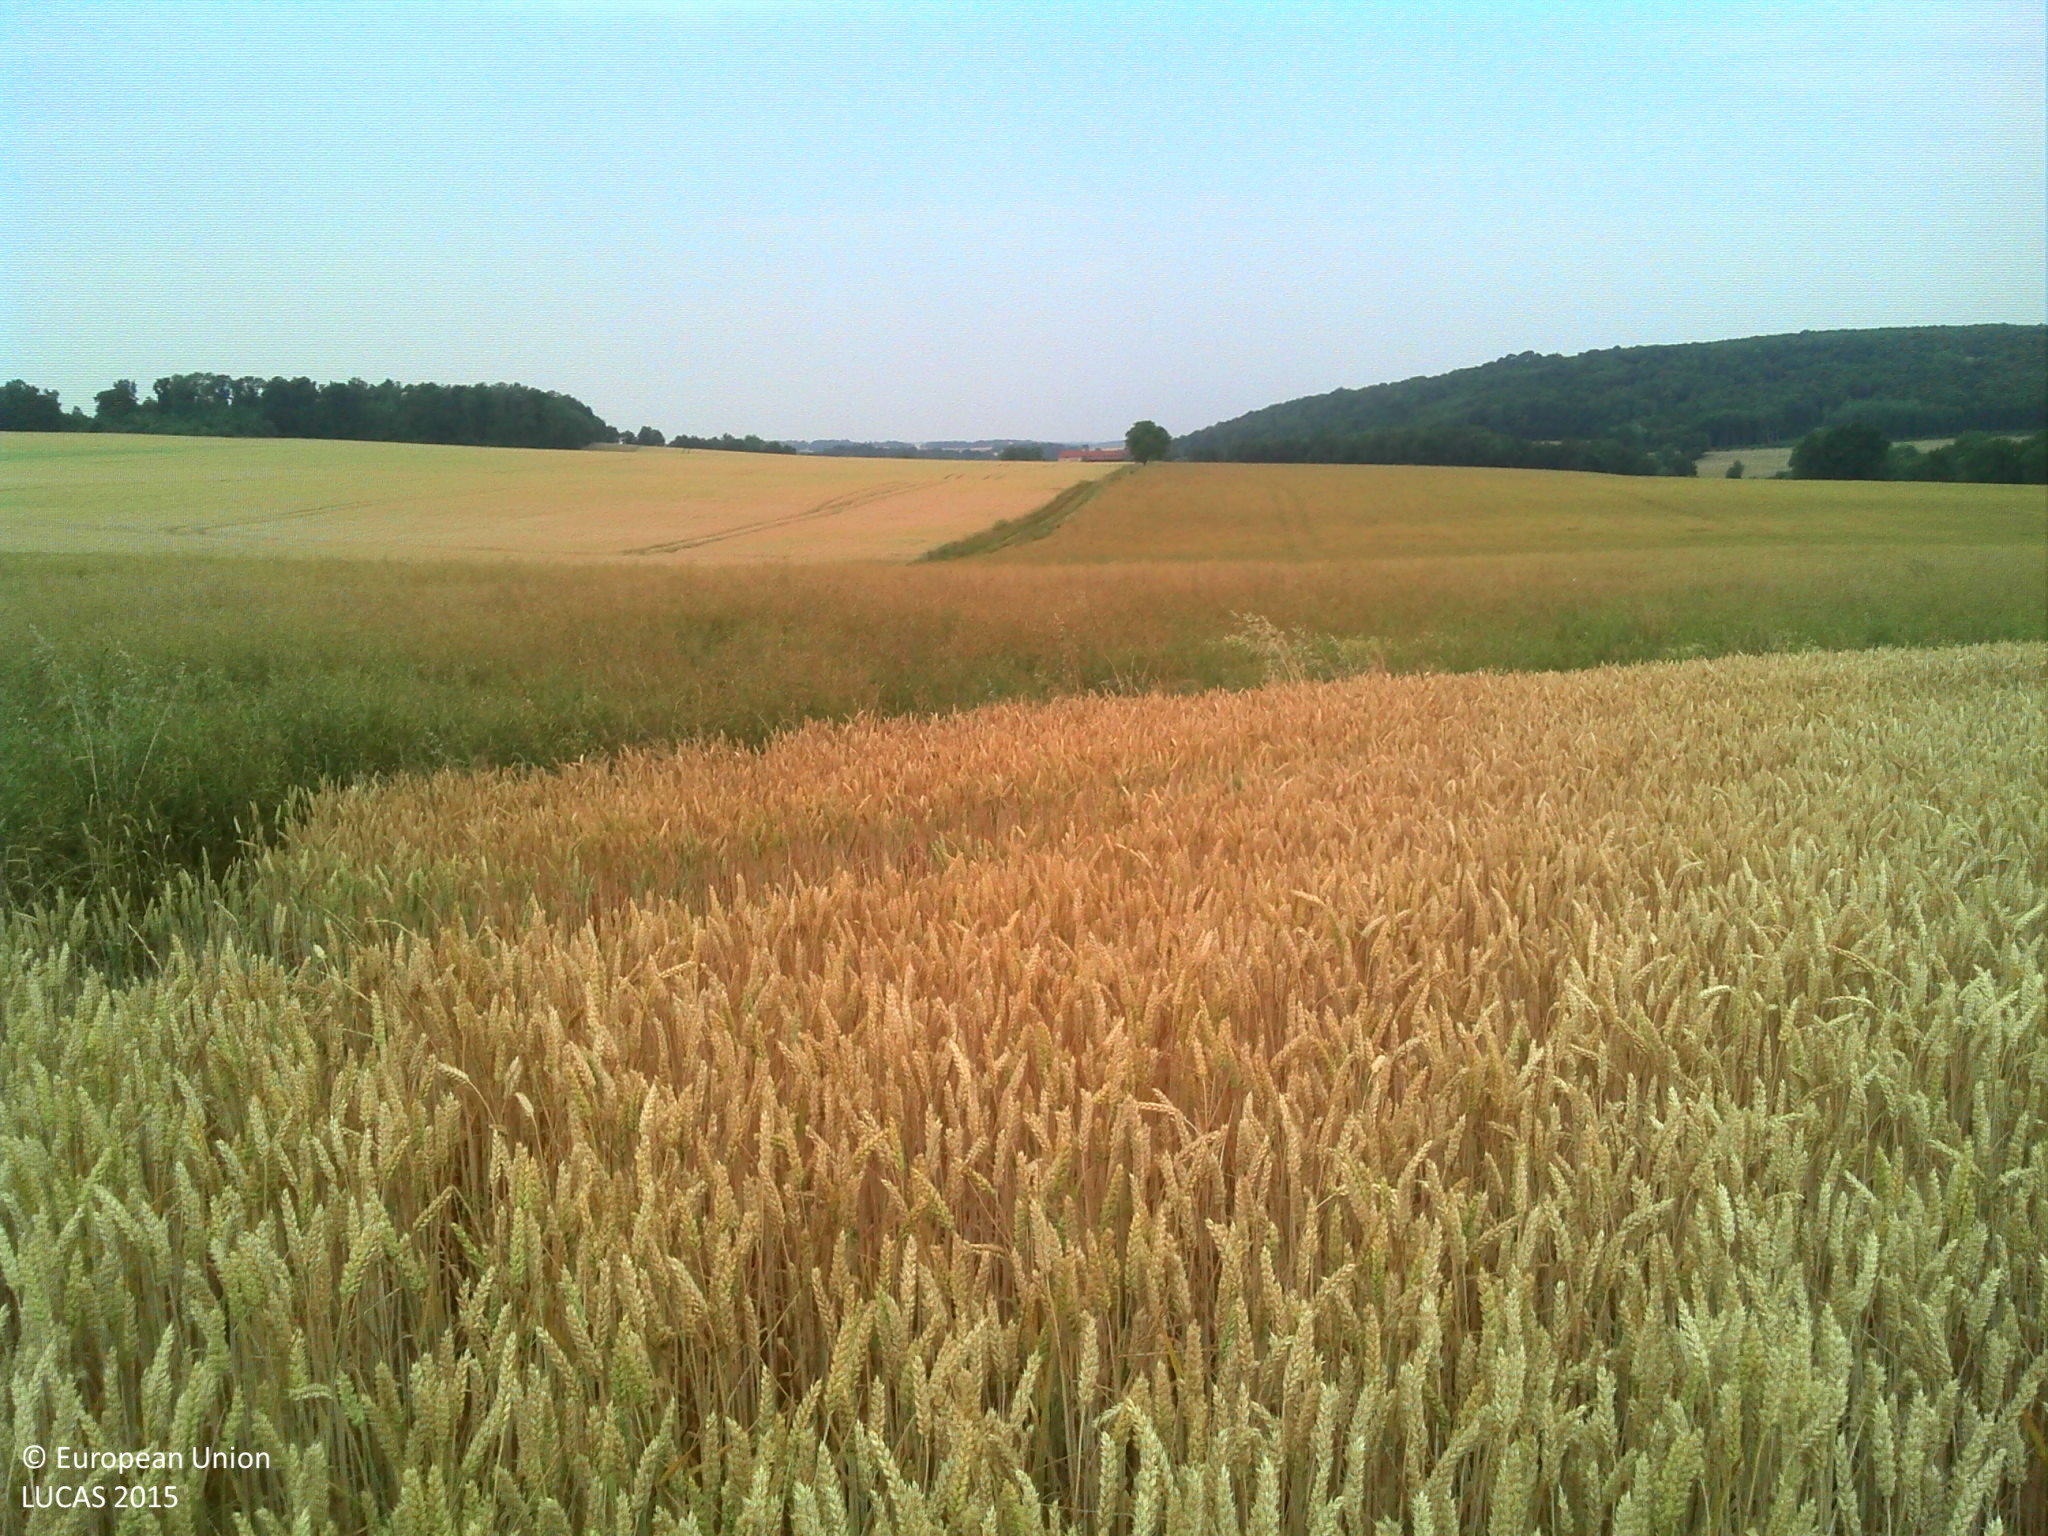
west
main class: Cropland
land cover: Common wheat
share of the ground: > 75 %
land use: Agriculture (excluding fallow land and kitchen gardens)
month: July
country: FR
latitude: 49.0862
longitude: 3.3242
